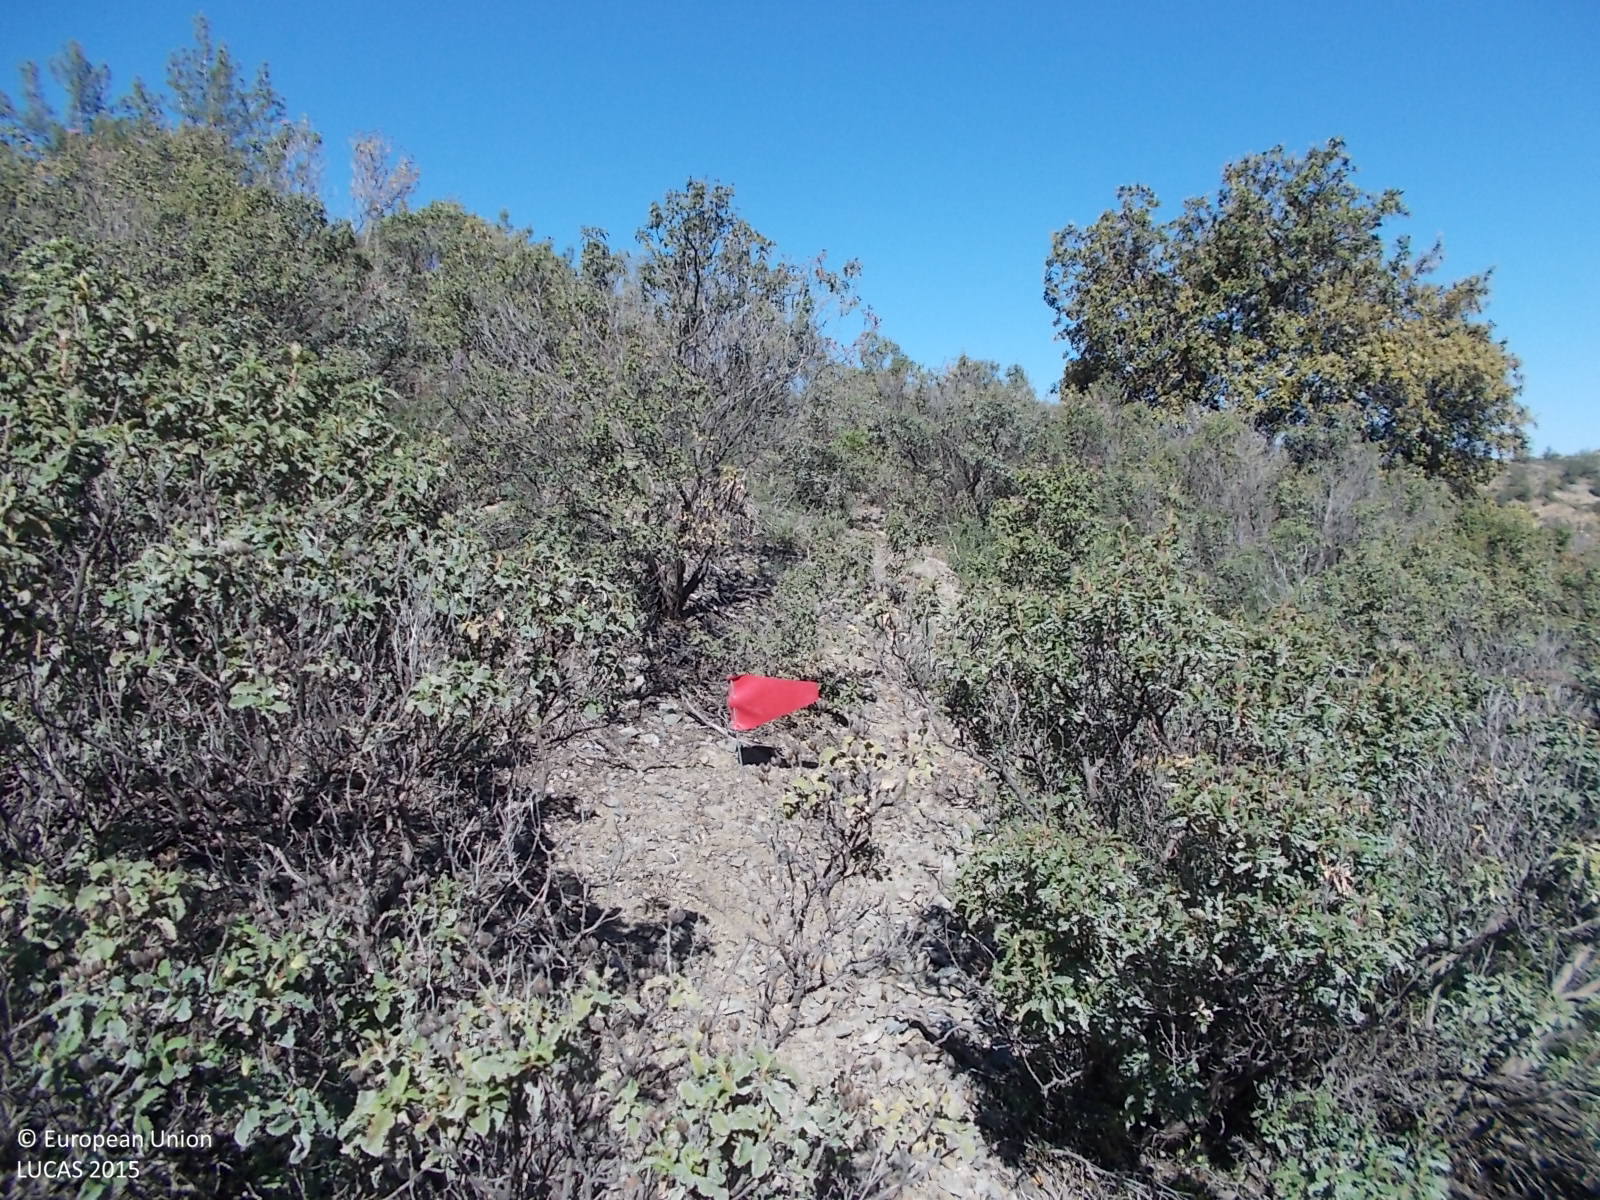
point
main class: Shrubland
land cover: Shrubland with sparse tree cover
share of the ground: > 75 %
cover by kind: shrubs 95 %, broadleaved forest trees 5 %
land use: Semi-natural and natural areas not in use
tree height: < 5 m
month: May
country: CY
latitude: 34.8810
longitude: 33.0265
